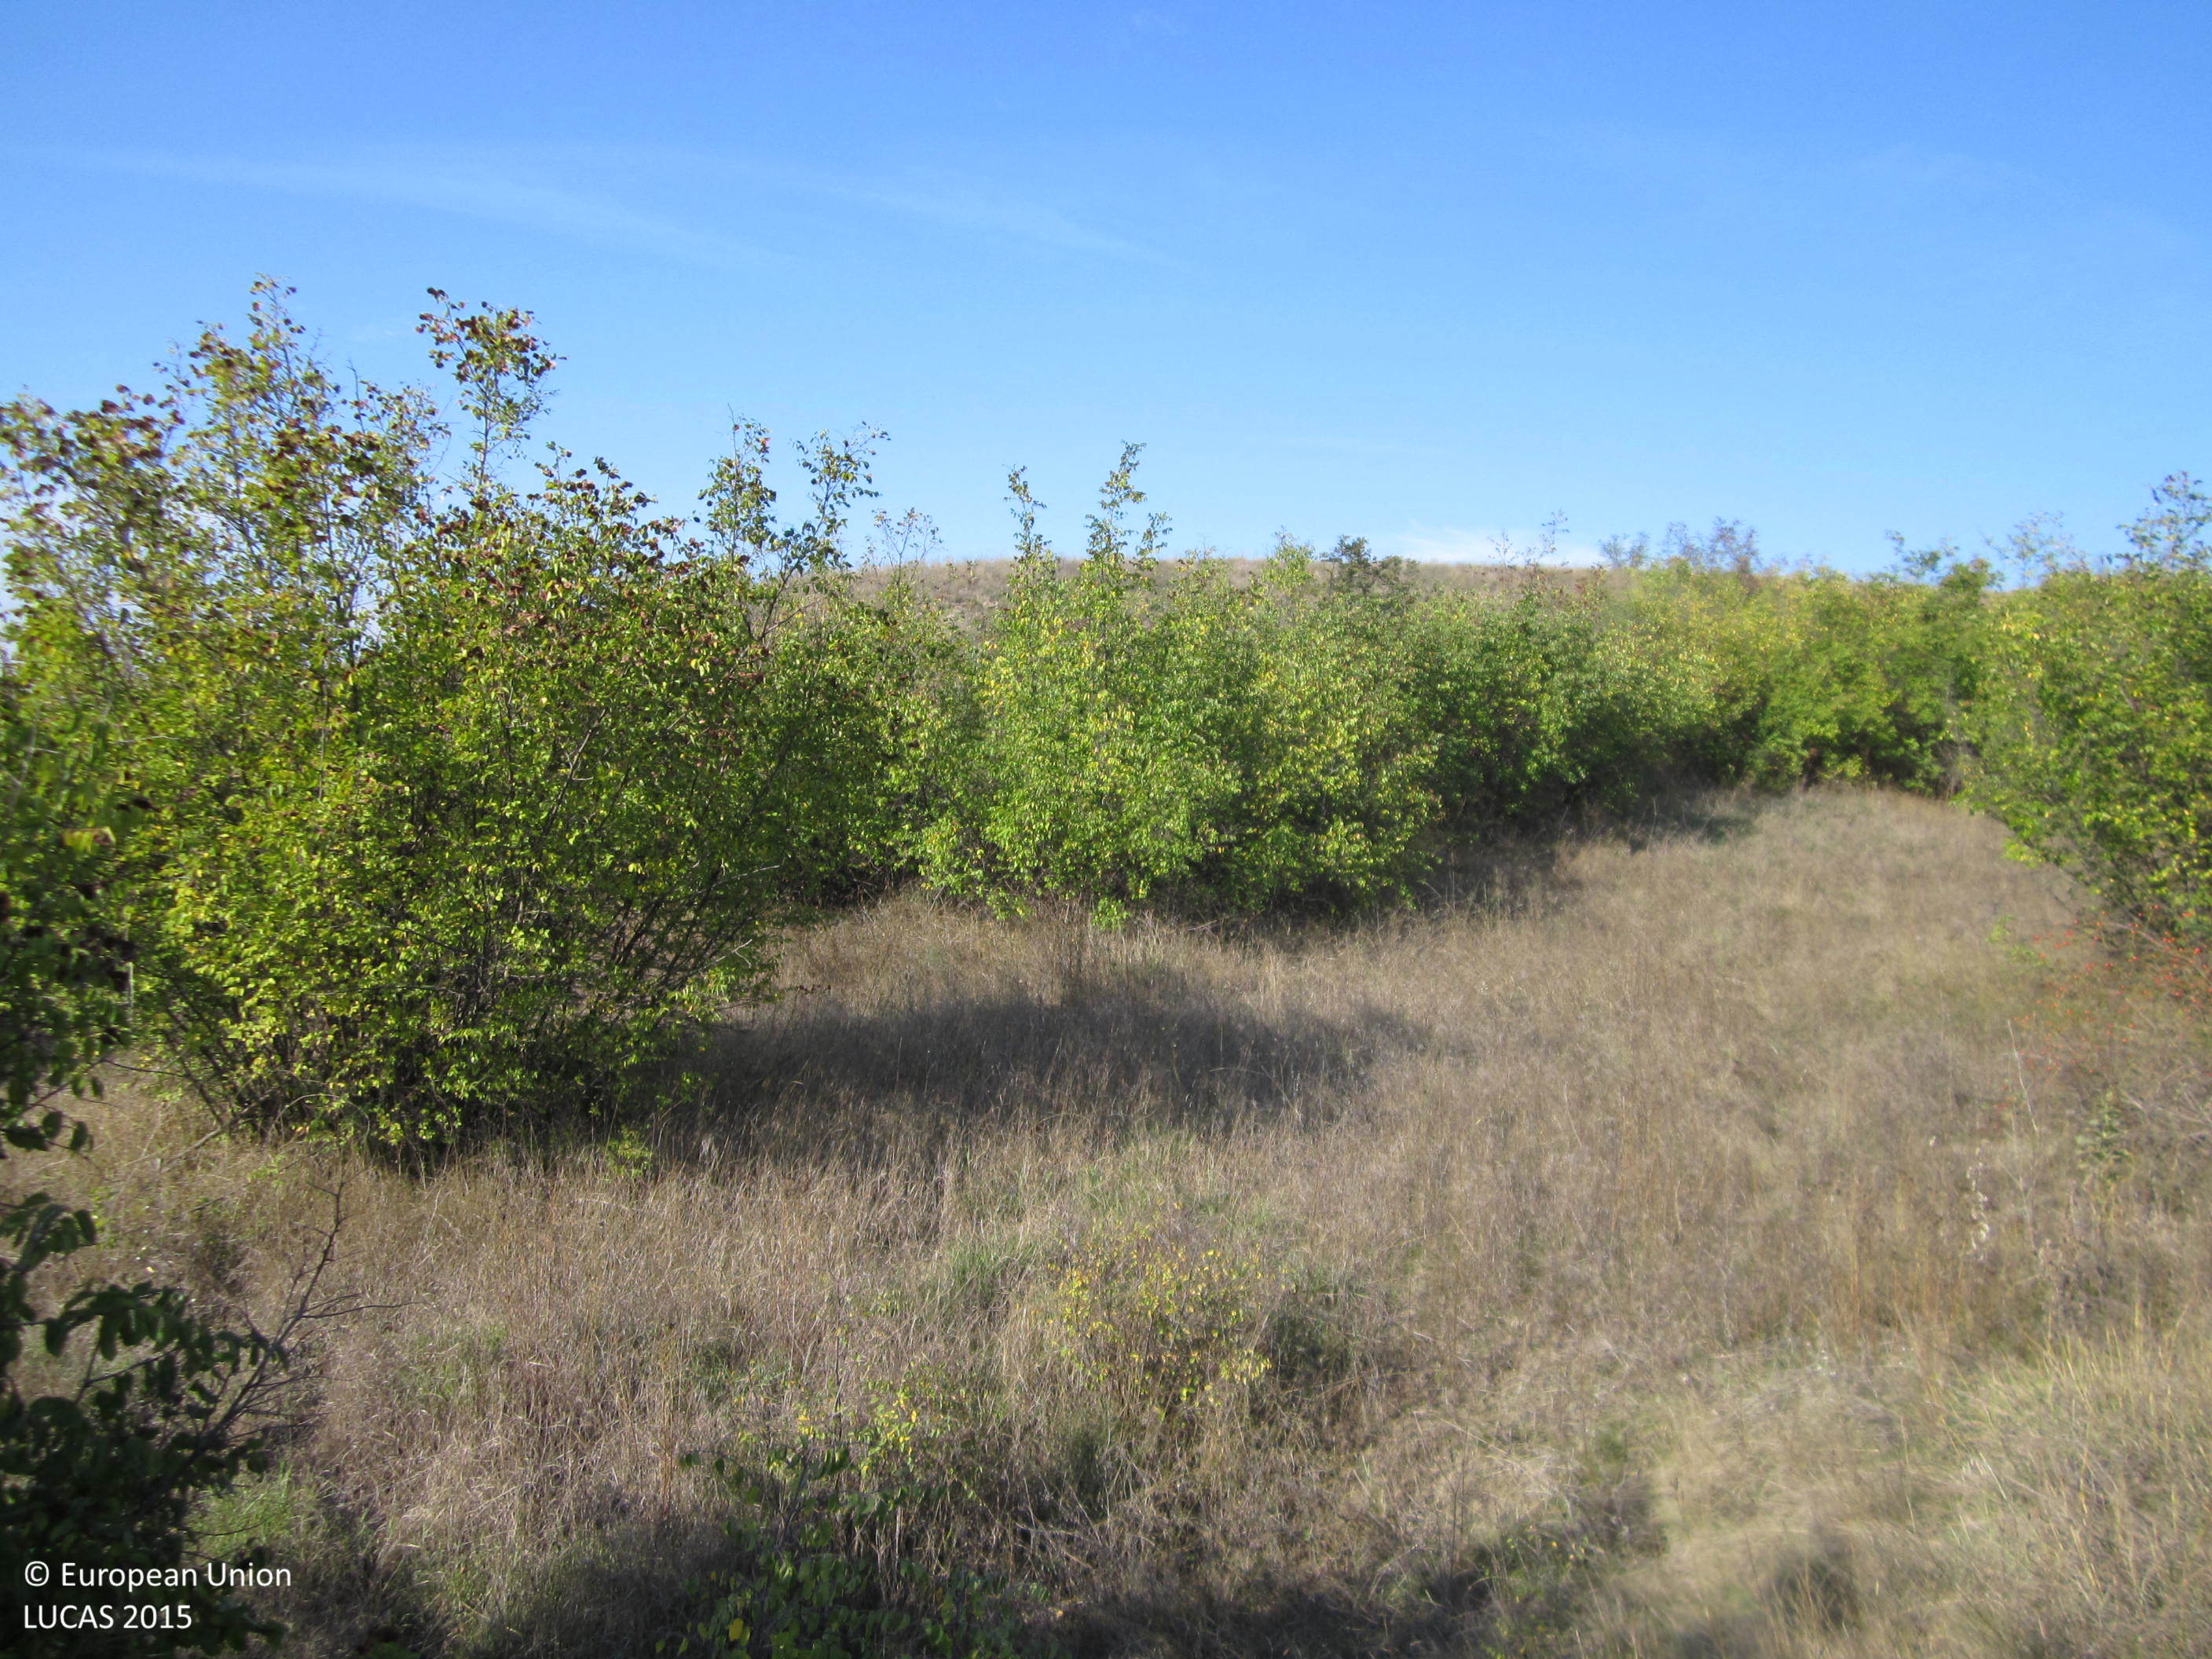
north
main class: Grassland
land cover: Grassland with sparse tree/shrub cover
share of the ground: > 75 %
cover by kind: herbaceous plants 85 %, shrubs 10 %, broadleaved forest trees 5 %
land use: Agriculture (excluding fallow land and kitchen gardens)
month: October
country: BG
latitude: 42.6518
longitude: 26.8258
